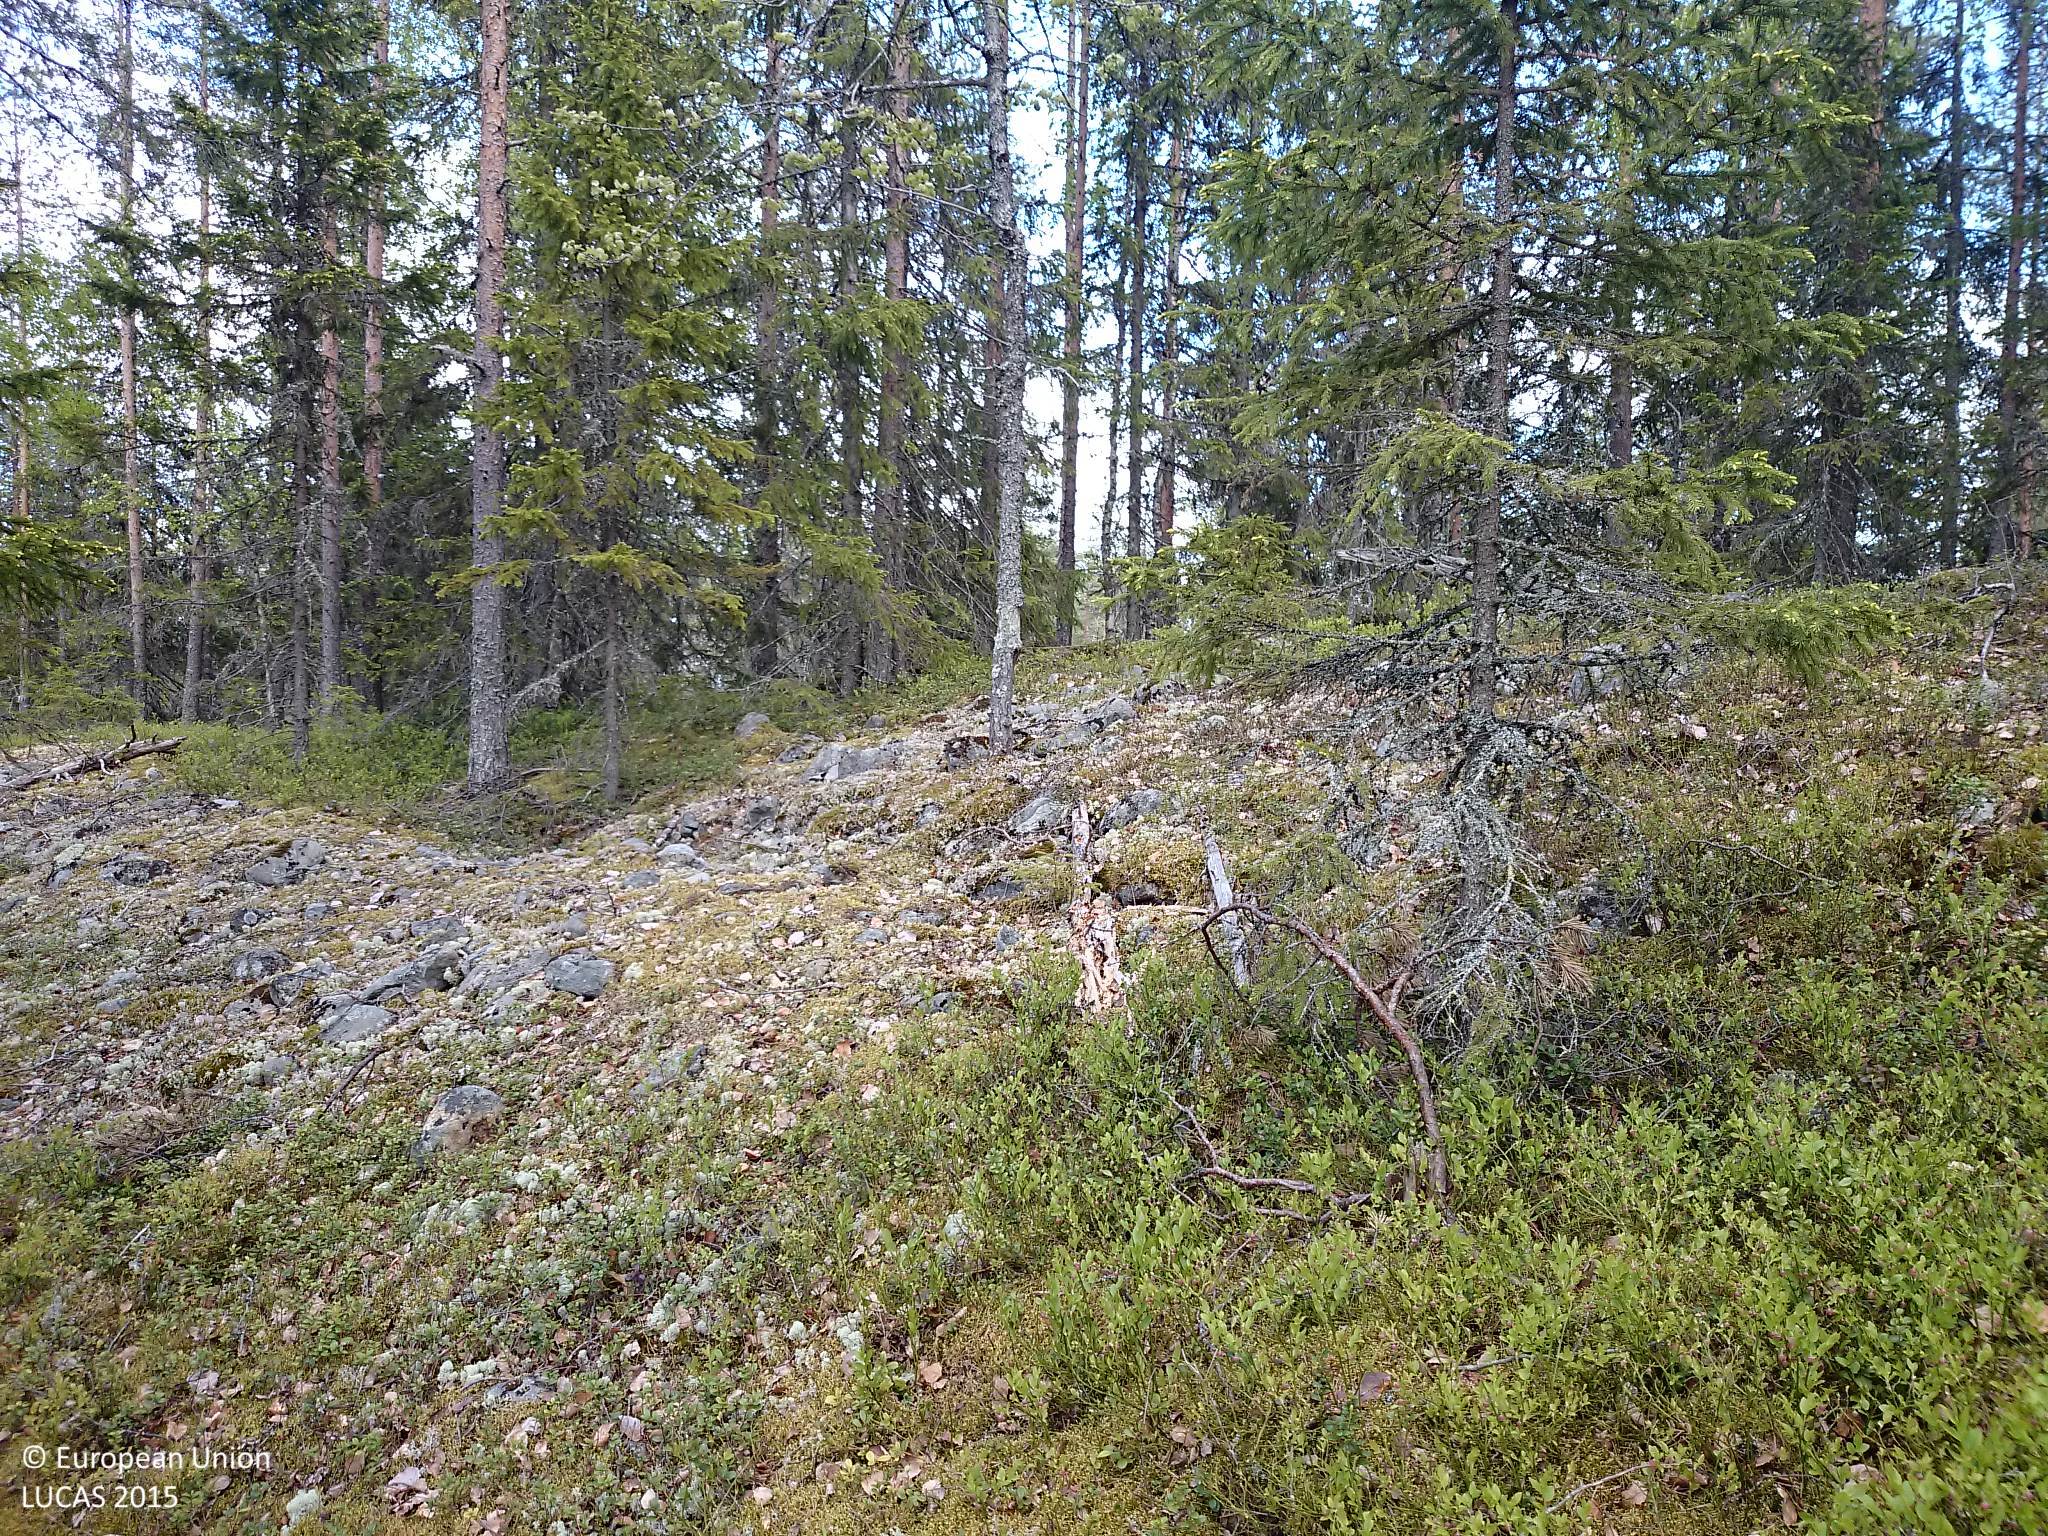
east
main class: Woodland
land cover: Other coniferous woodland
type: boreal forest
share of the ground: 25 - 50 %
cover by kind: coniferous forest trees 50 %, shrubs 40 %, lichens and mosses 5 %, consolidated bare surface 5 %
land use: Forestry
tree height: > 5 m
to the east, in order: Other coniferous woodland; Pine dominated coniferous woodland; Other mixed woodland
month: June
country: SE
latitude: 64.1451
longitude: 20.1517
